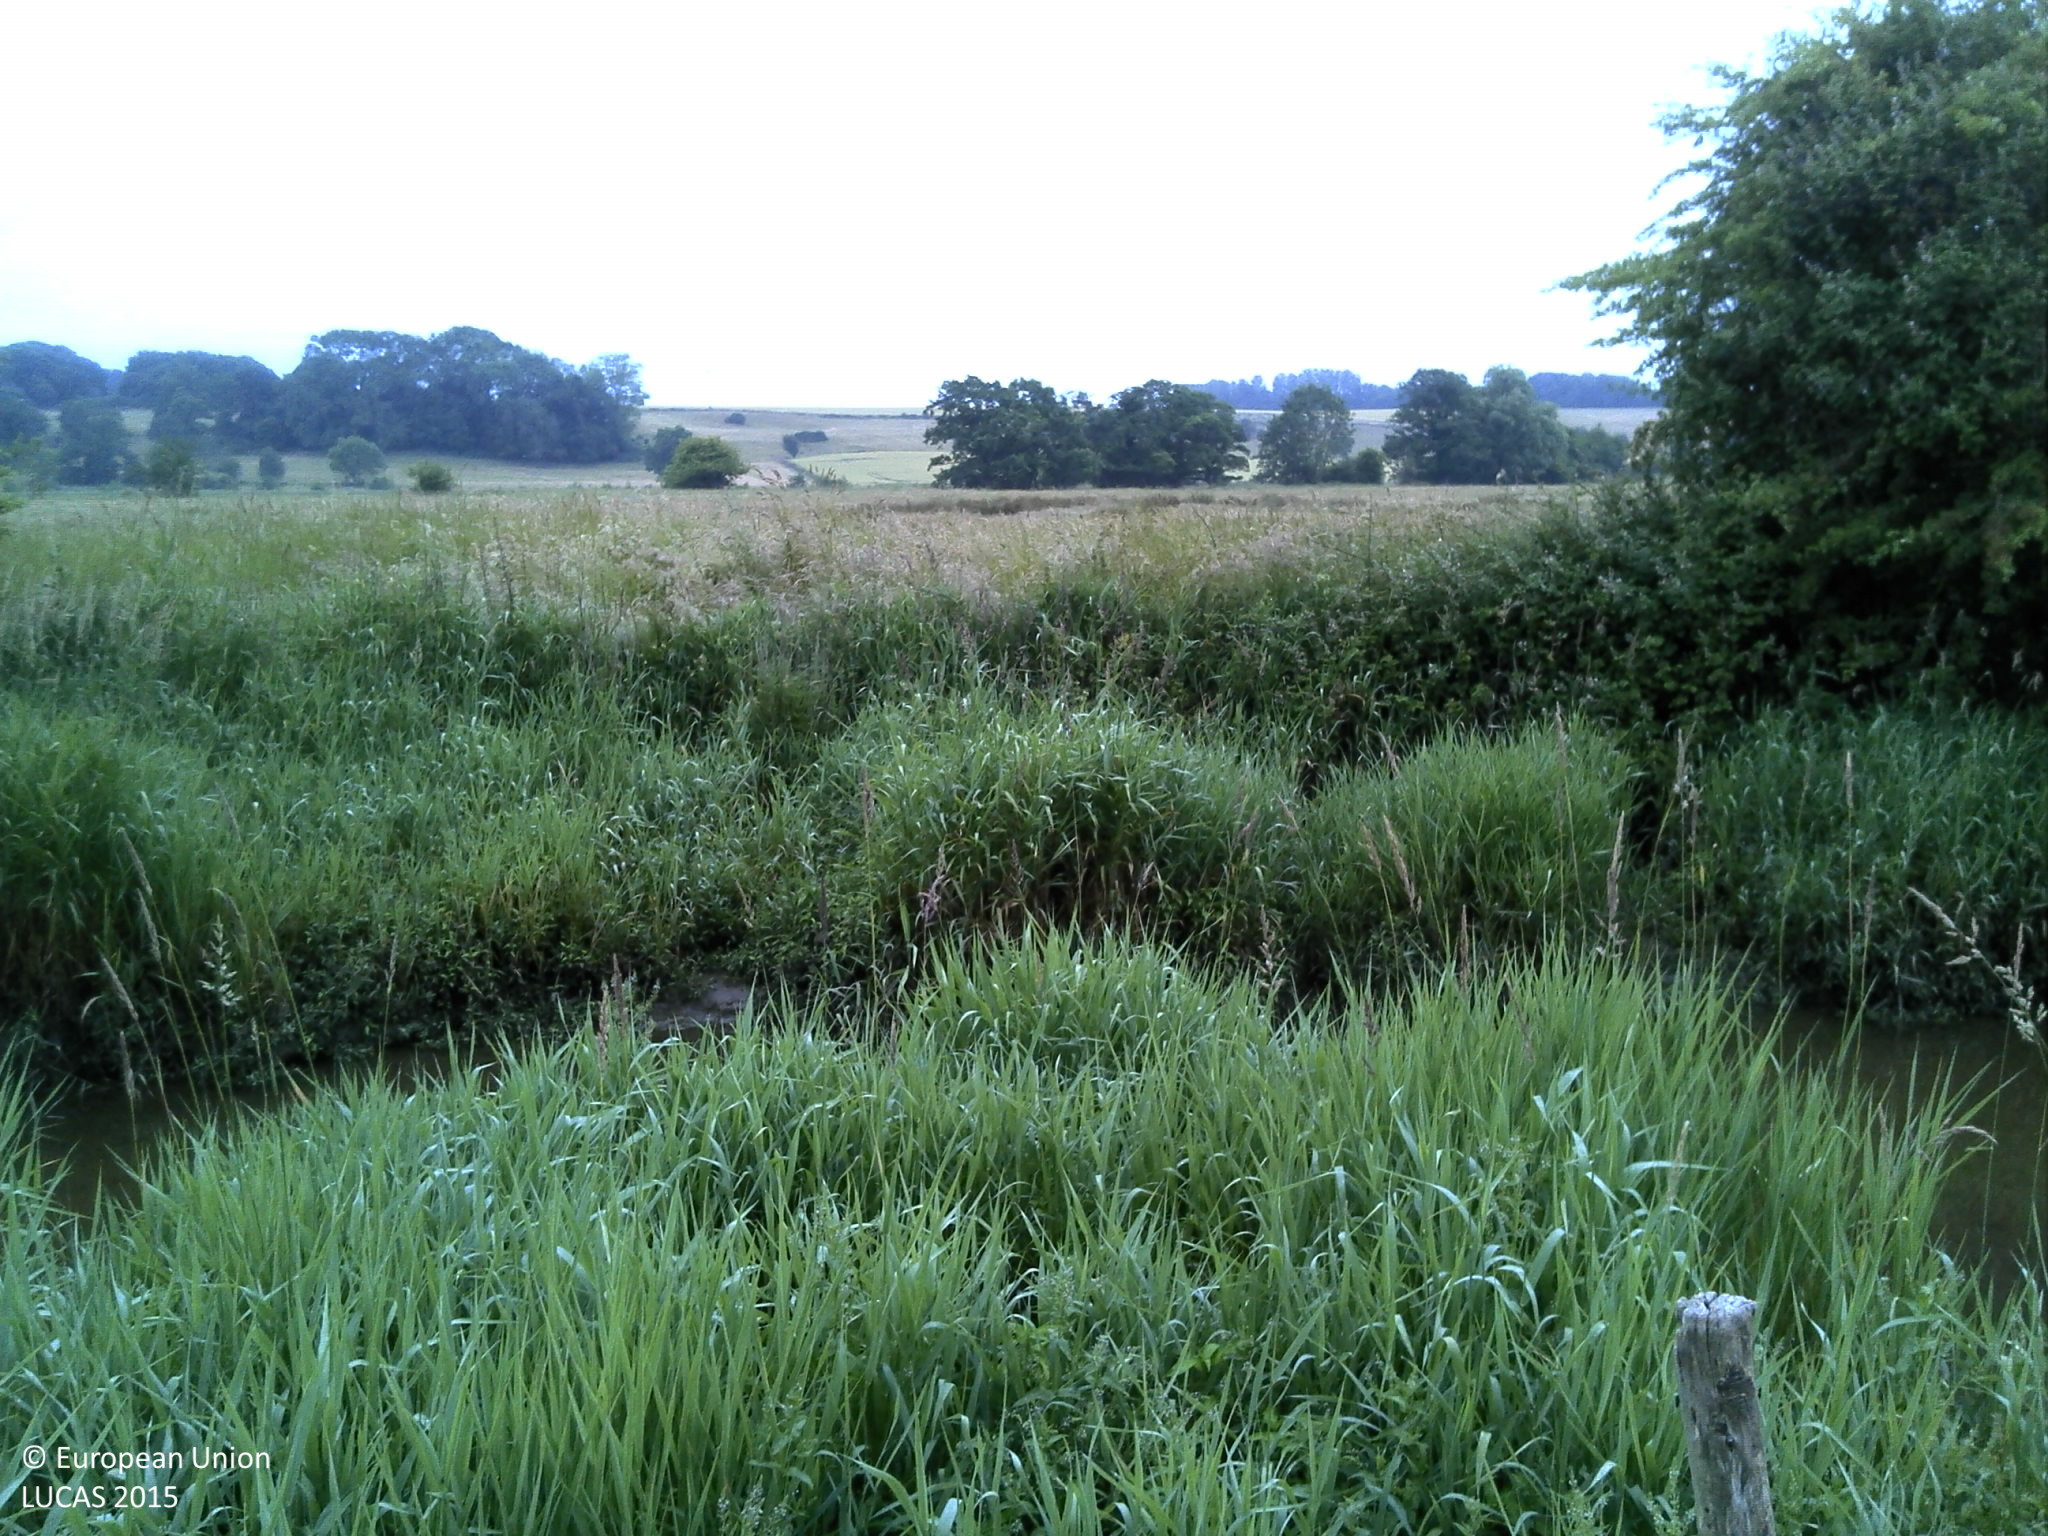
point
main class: Grassland
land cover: Grassland without tree/shrub cover
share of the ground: > 75 %
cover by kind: herbaceous plants 100 %
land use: Agriculture (excluding fallow land and kitchen gardens)
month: July
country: FR
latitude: 49.8955
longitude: 0.9421
